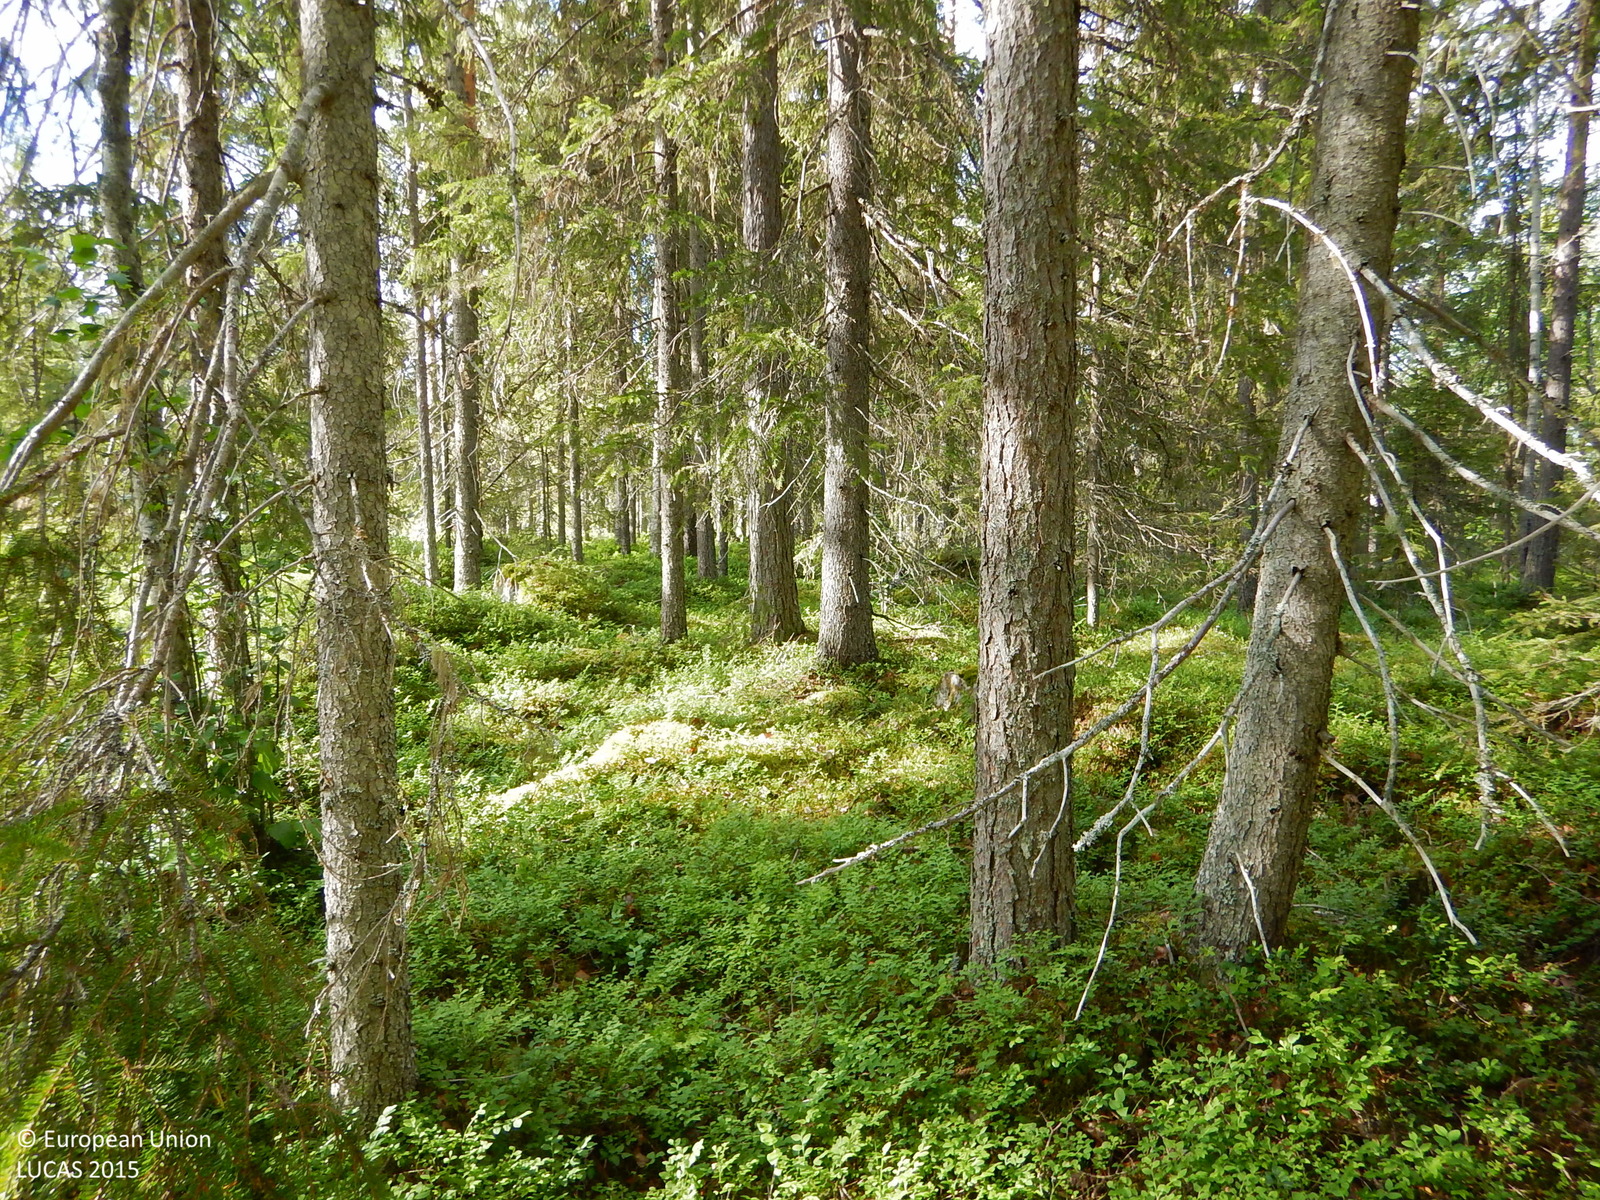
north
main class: Woodland
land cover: Spruce dominated coniferous woodland
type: boreal forest
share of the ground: 50 - 75 %
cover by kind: coniferous forest trees 65 %, shrubs 15 %, lichens and mosses 10 %, broadleaved forest trees 5 %, herbaceous plants 5 %
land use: Forestry
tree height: > 5 m
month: July
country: SE
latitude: 64.8249
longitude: 20.3601
